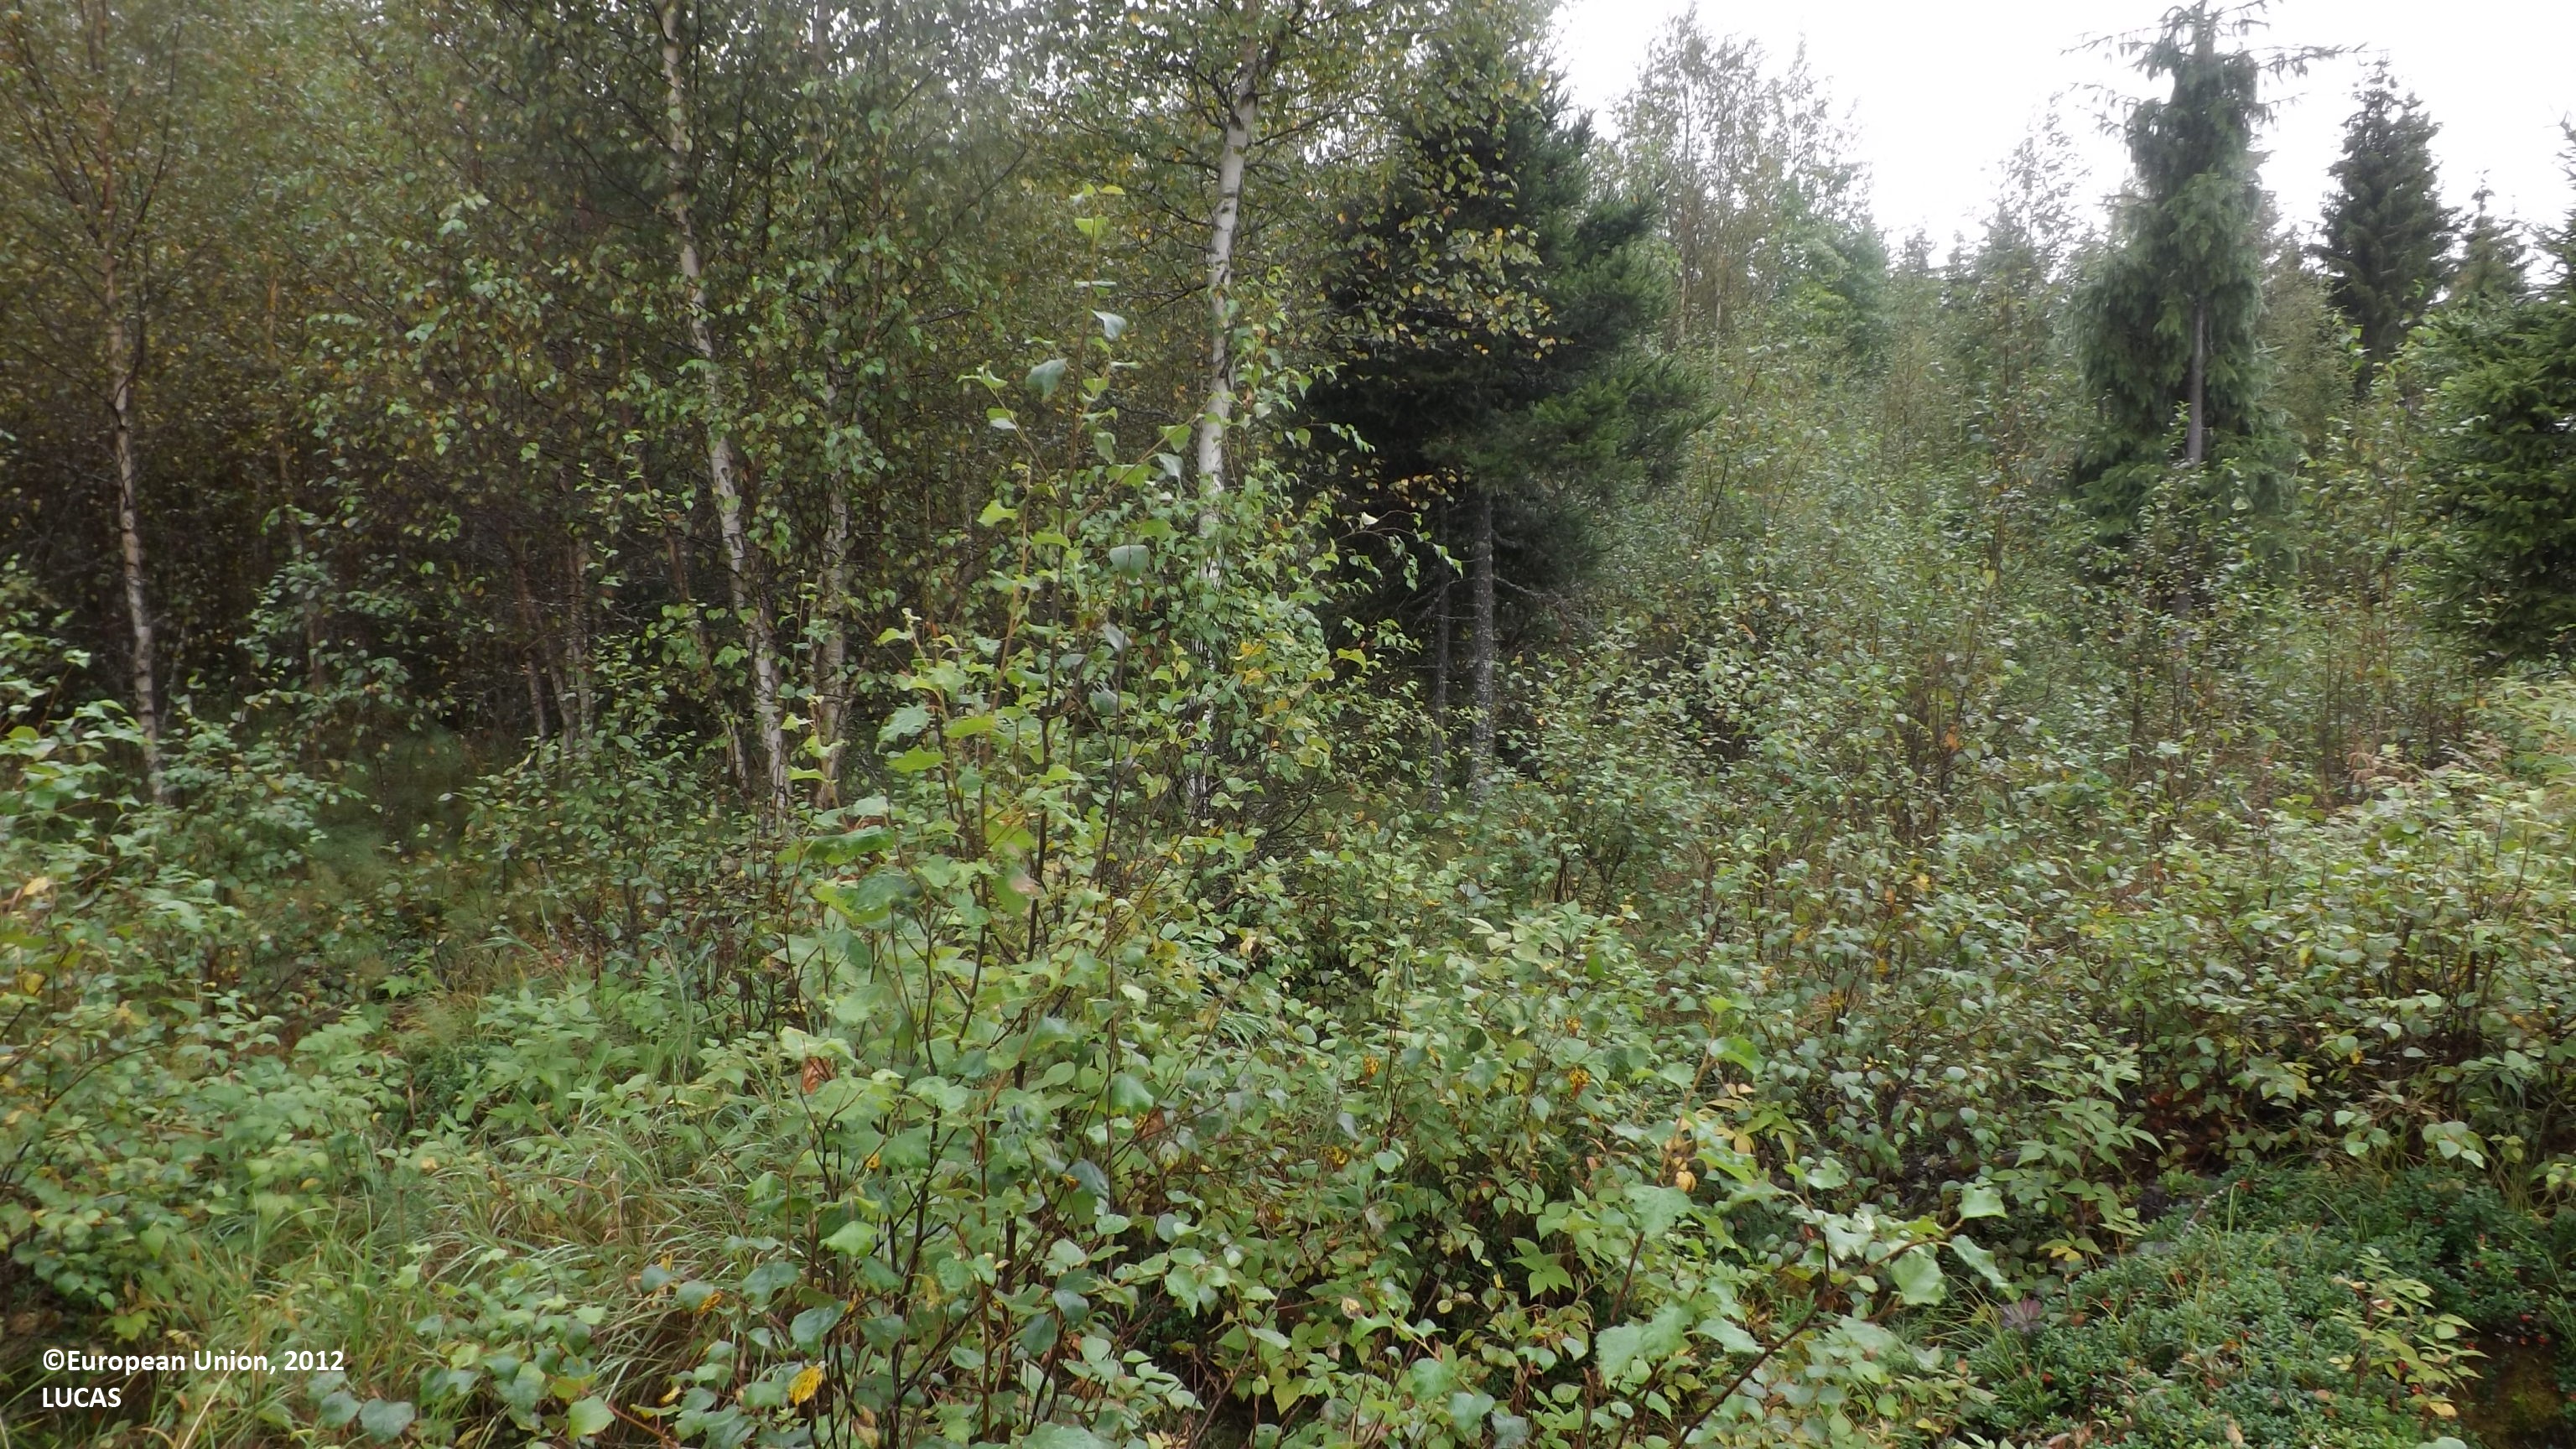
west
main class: Shrubland
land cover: Shrubland with sparse tree cover
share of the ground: 50 - 75 %
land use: Forestry
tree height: < 5 m
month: August
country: FI
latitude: 63.8053
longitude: 23.6452
